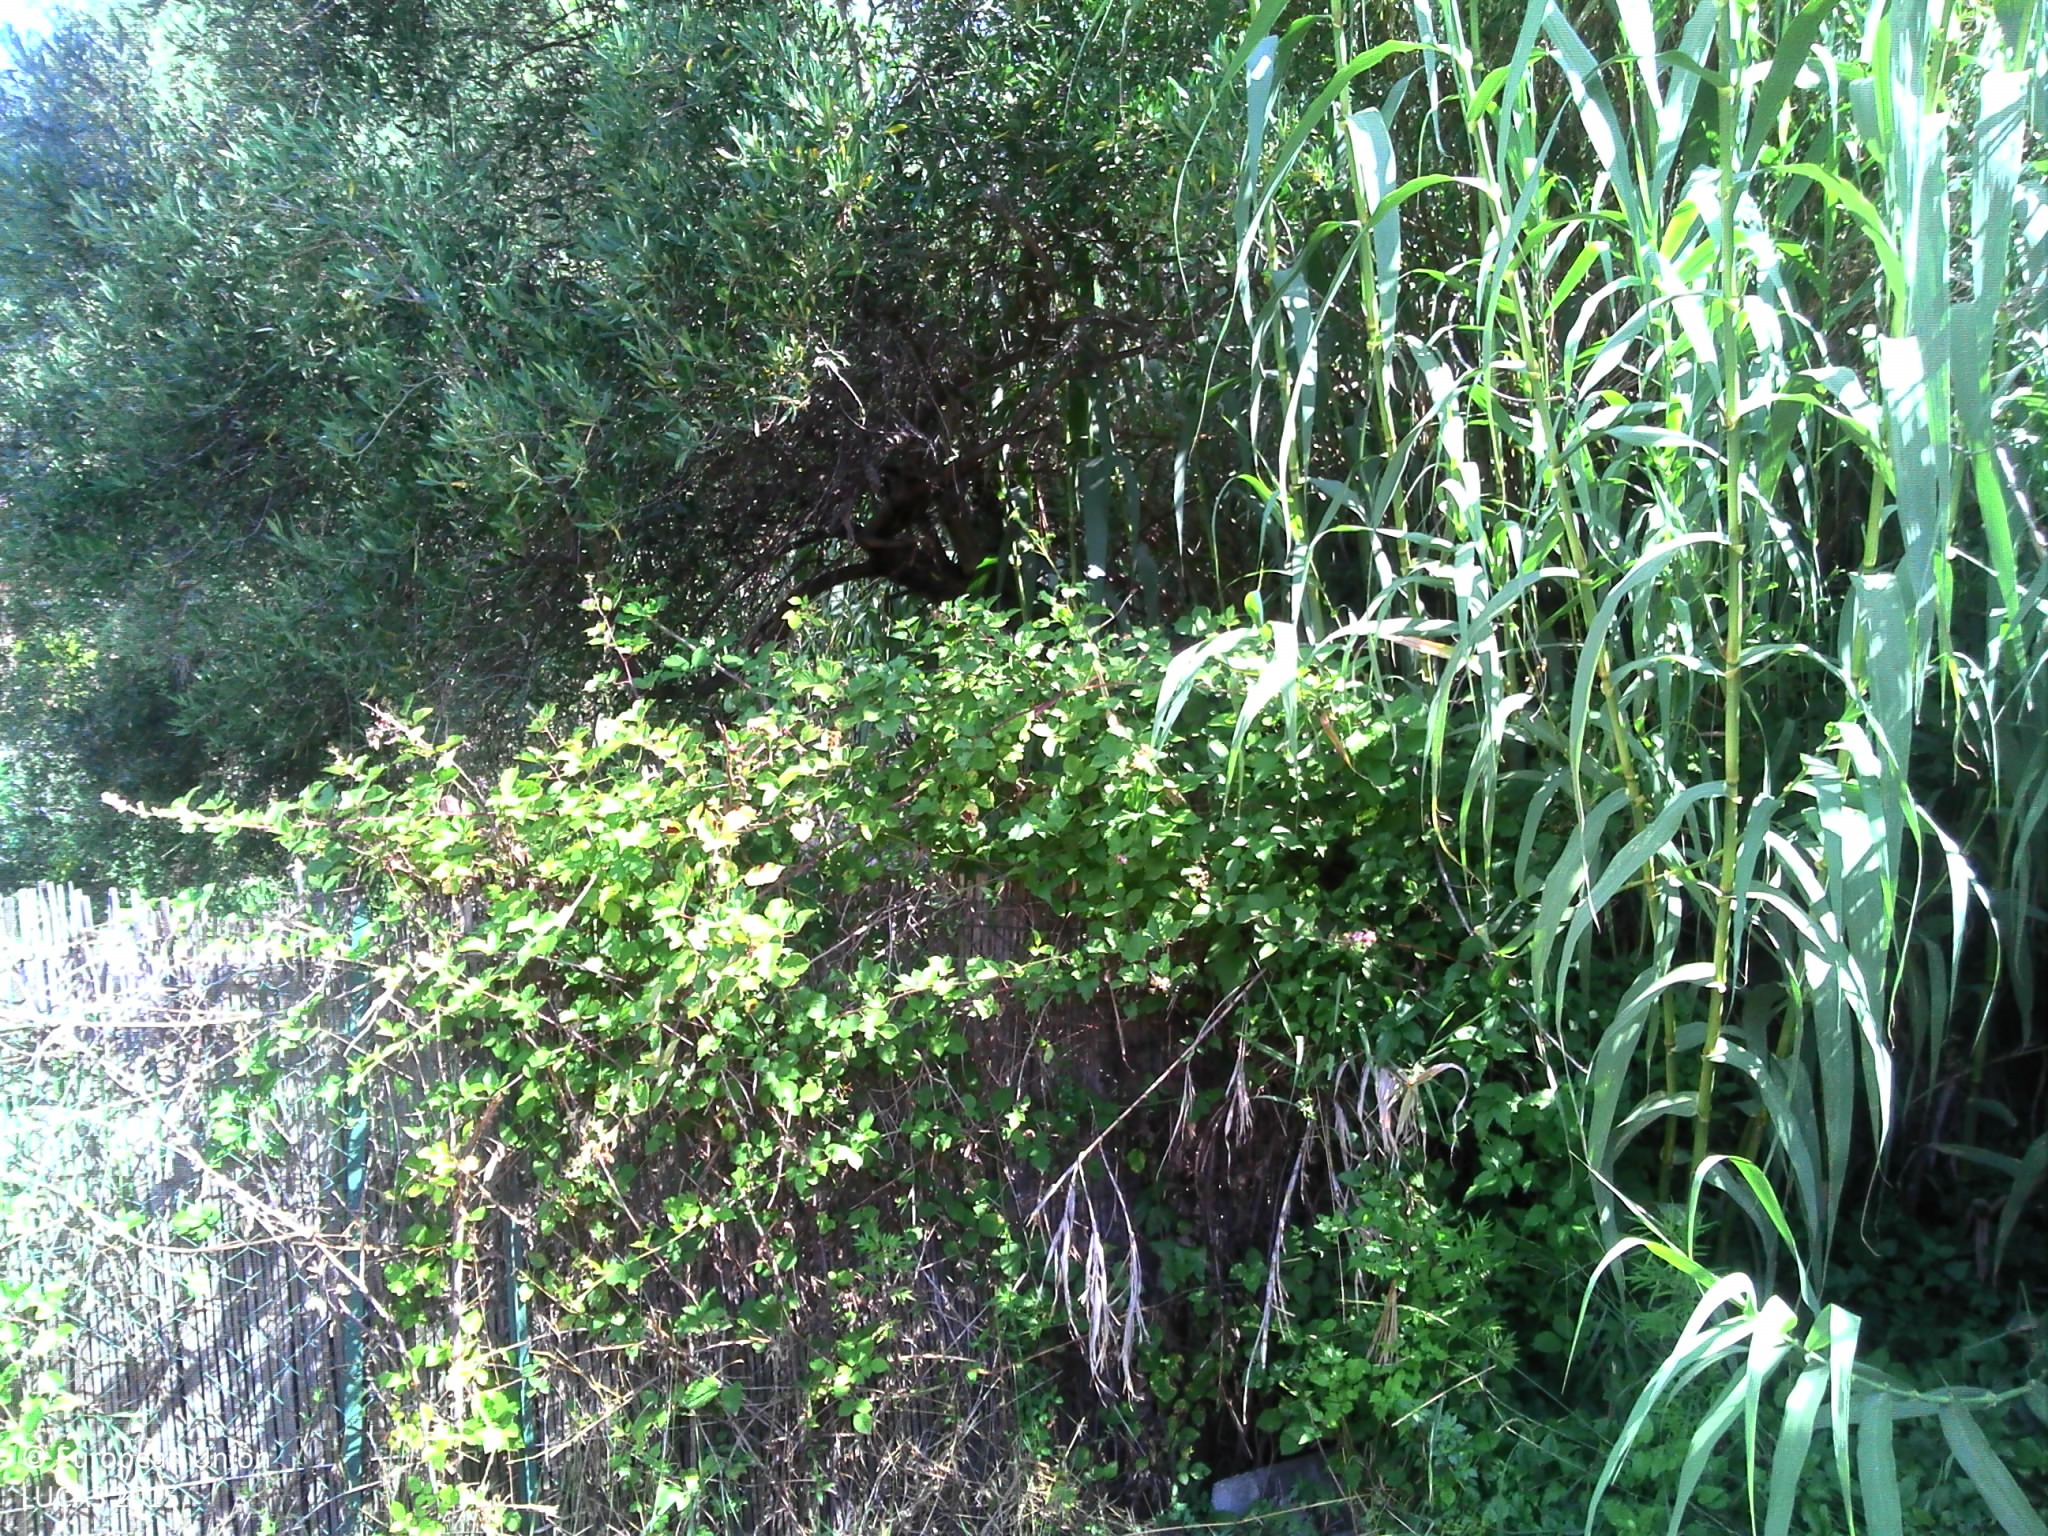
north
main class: Grassland
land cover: Spontaneously vegetated surfaces
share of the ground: > 75 %
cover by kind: herbaceous plants 80 %, consolidated bare surface 15 %, shrubs 5 %
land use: Semi-natural and natural areas not in use
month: June
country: FR
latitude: 43.7134
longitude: 7.0656
